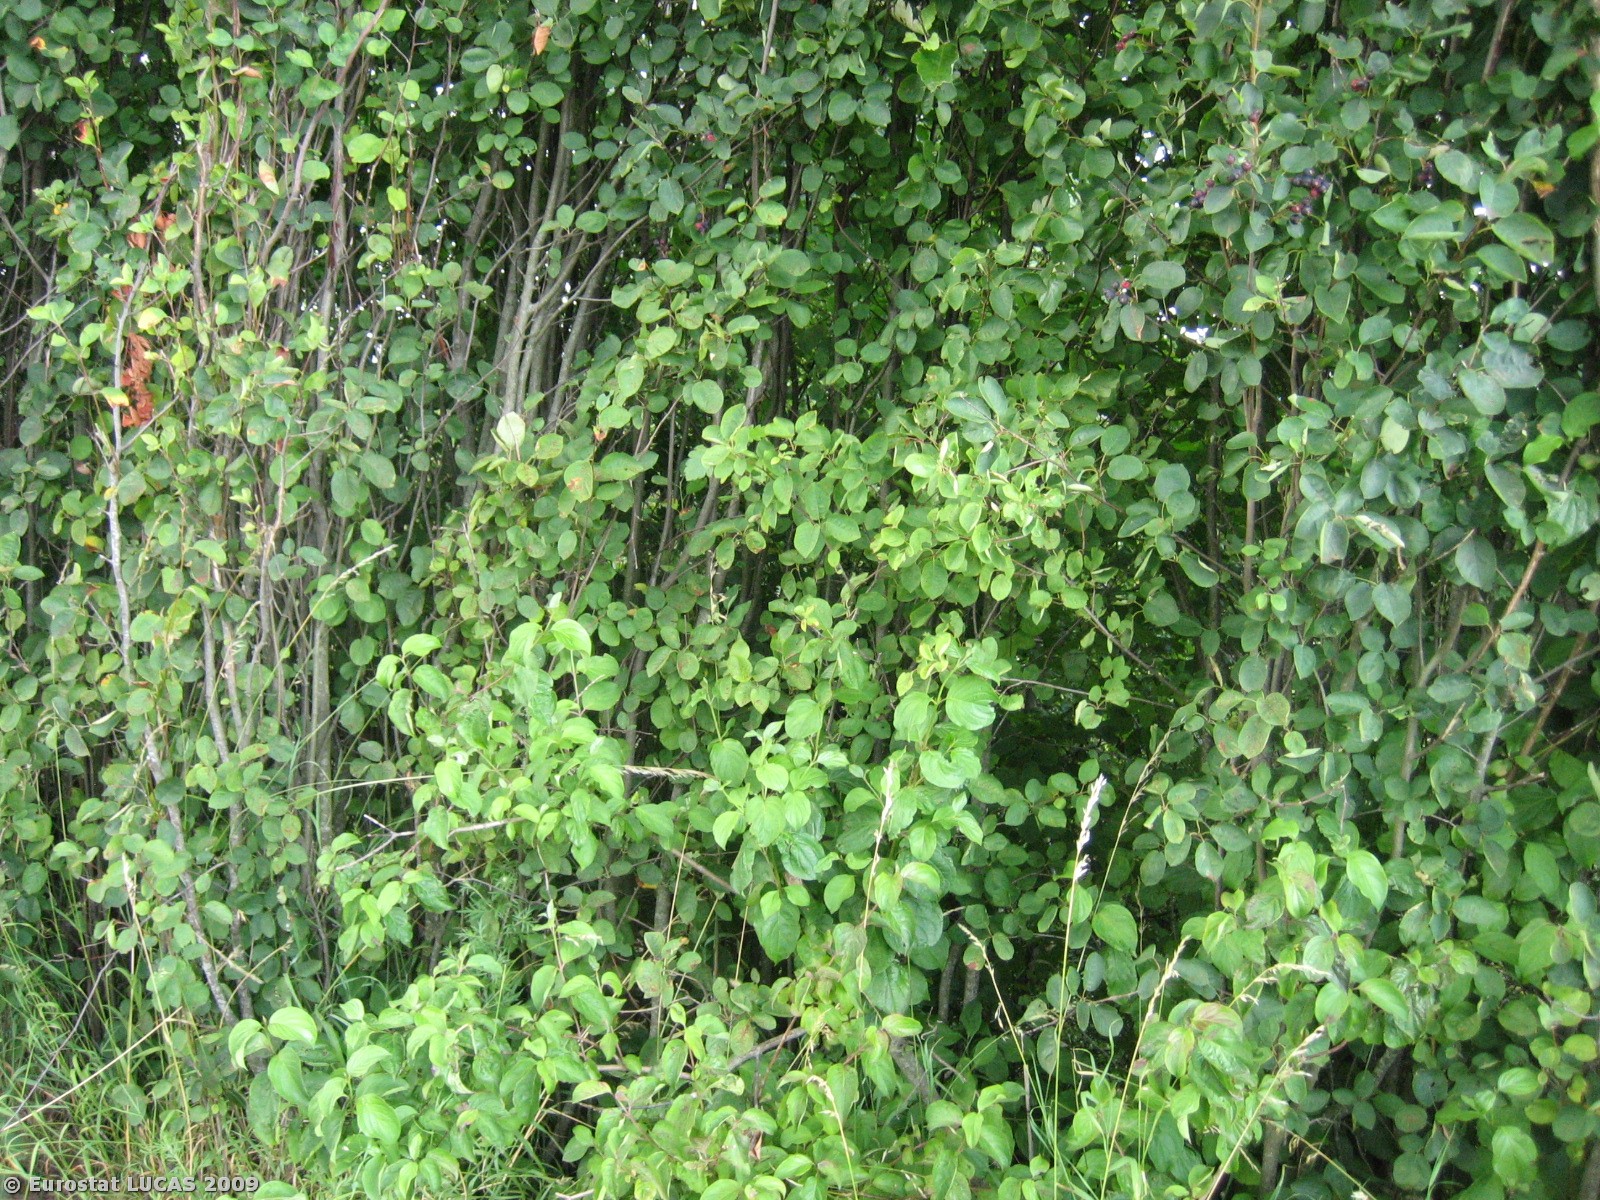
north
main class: Cropland
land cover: Dry pulses
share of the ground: 10 - 25 %
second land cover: Clovers
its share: 50 - 75 %
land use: Agriculture (excluding fallow land and kitchen gardens)
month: July
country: DK
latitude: 55.5403
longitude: 9.6992
